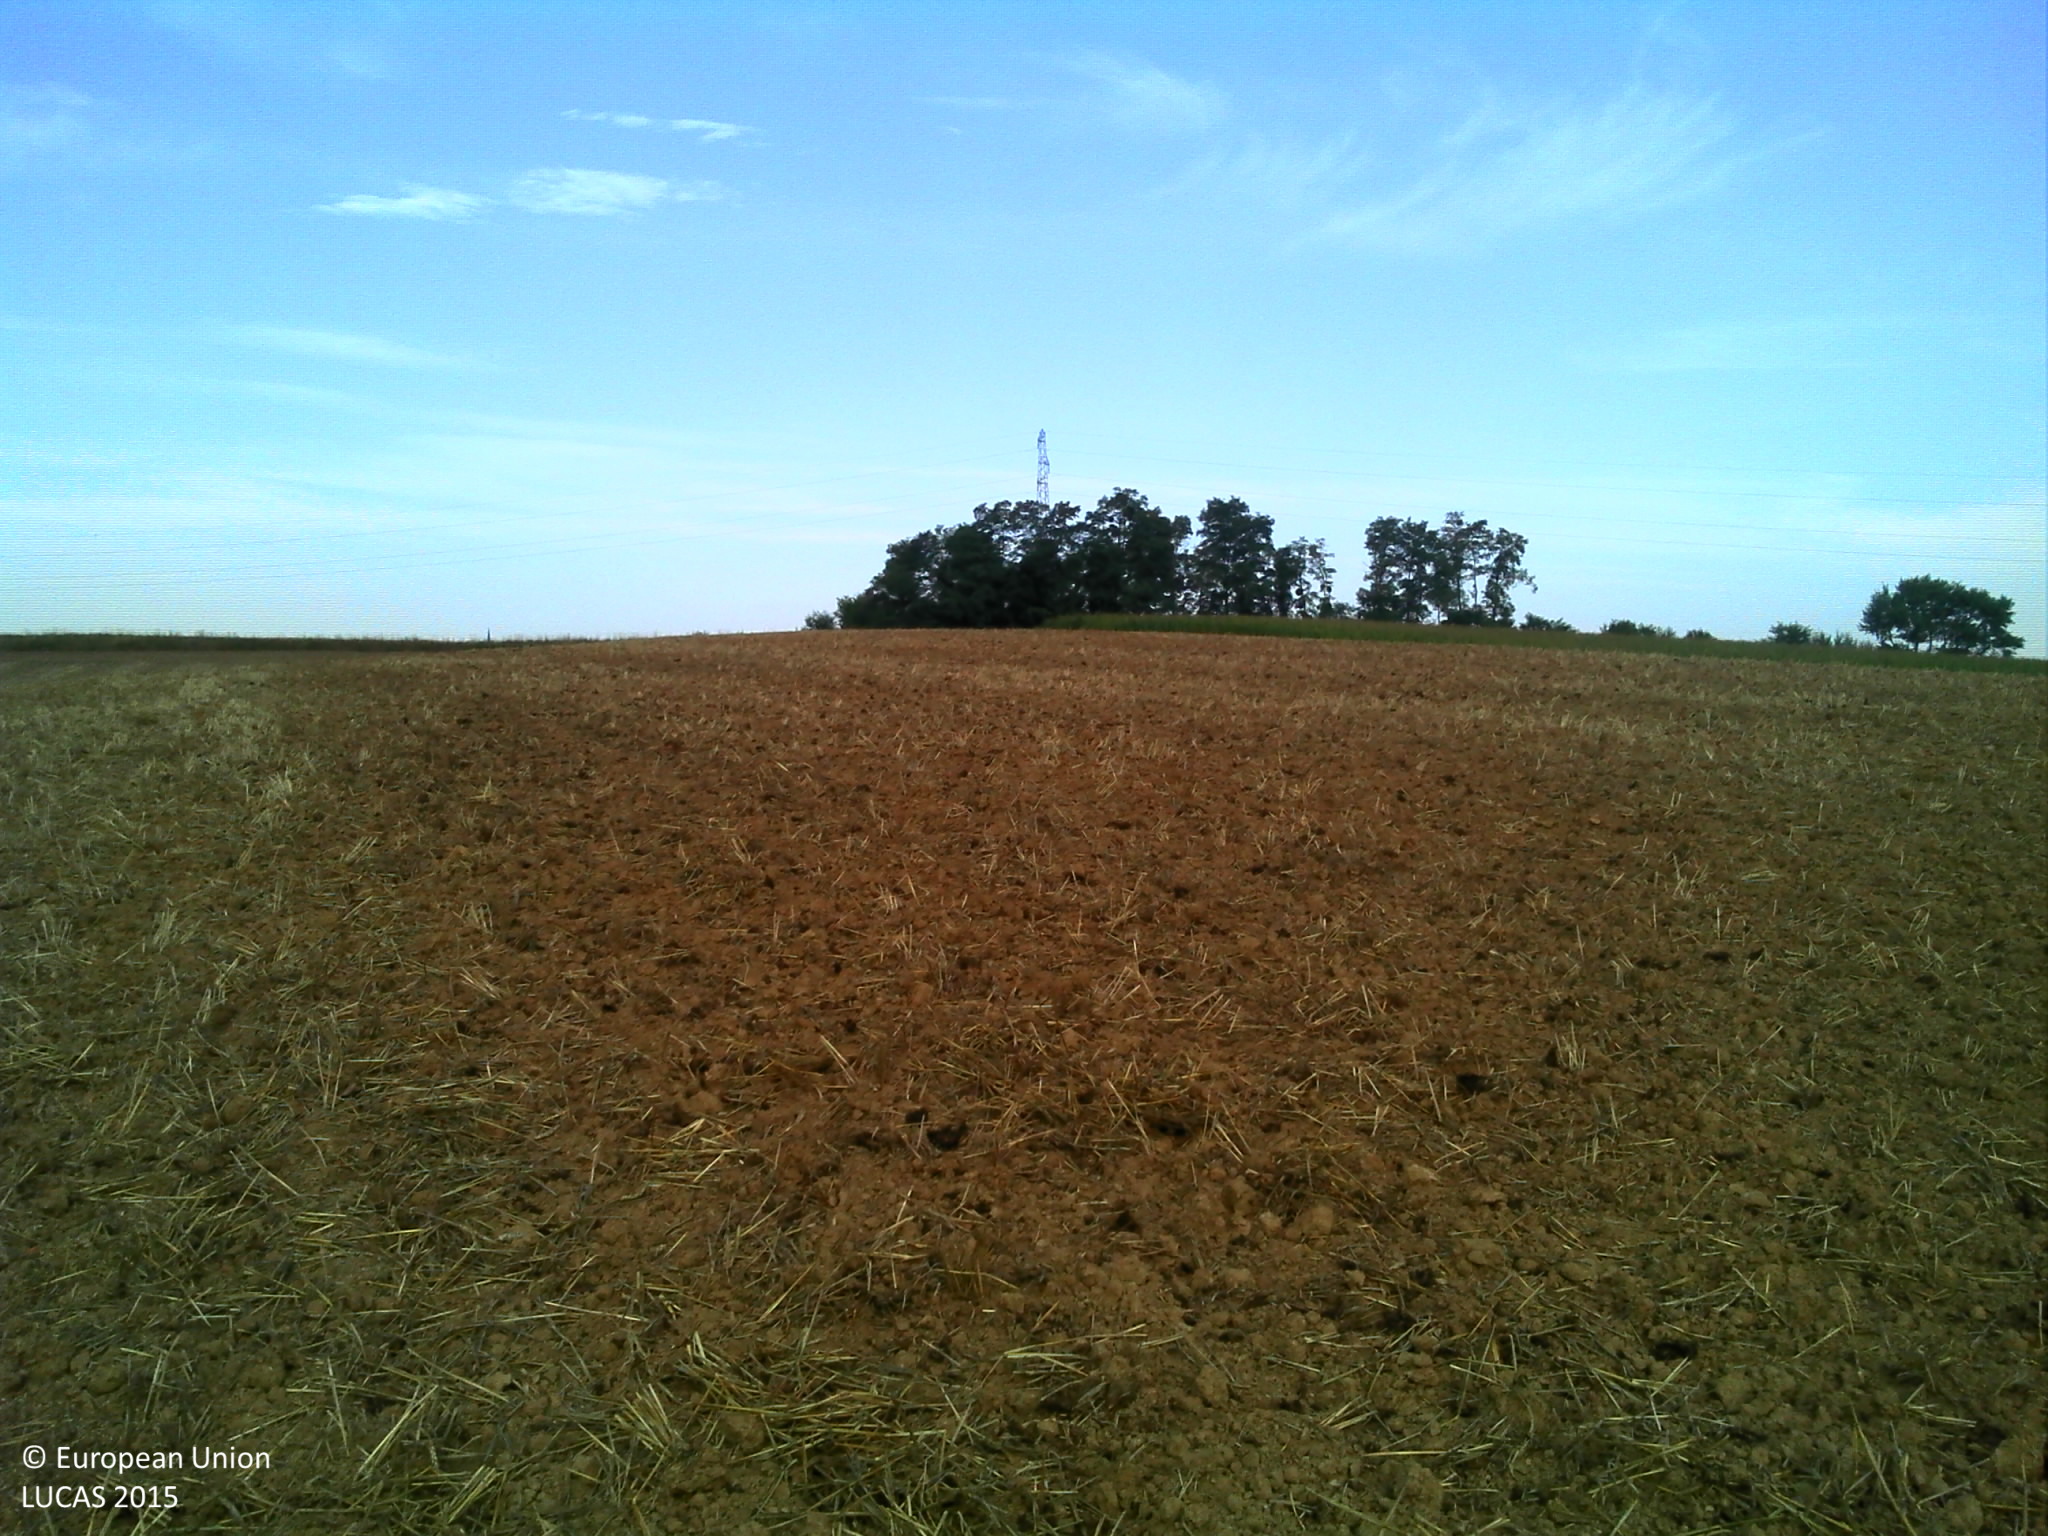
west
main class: Cropland
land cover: Common wheat
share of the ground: < 10 %
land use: Agriculture (excluding fallow land and kitchen gardens)
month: August
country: FR
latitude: 48.8638
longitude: 7.6151
